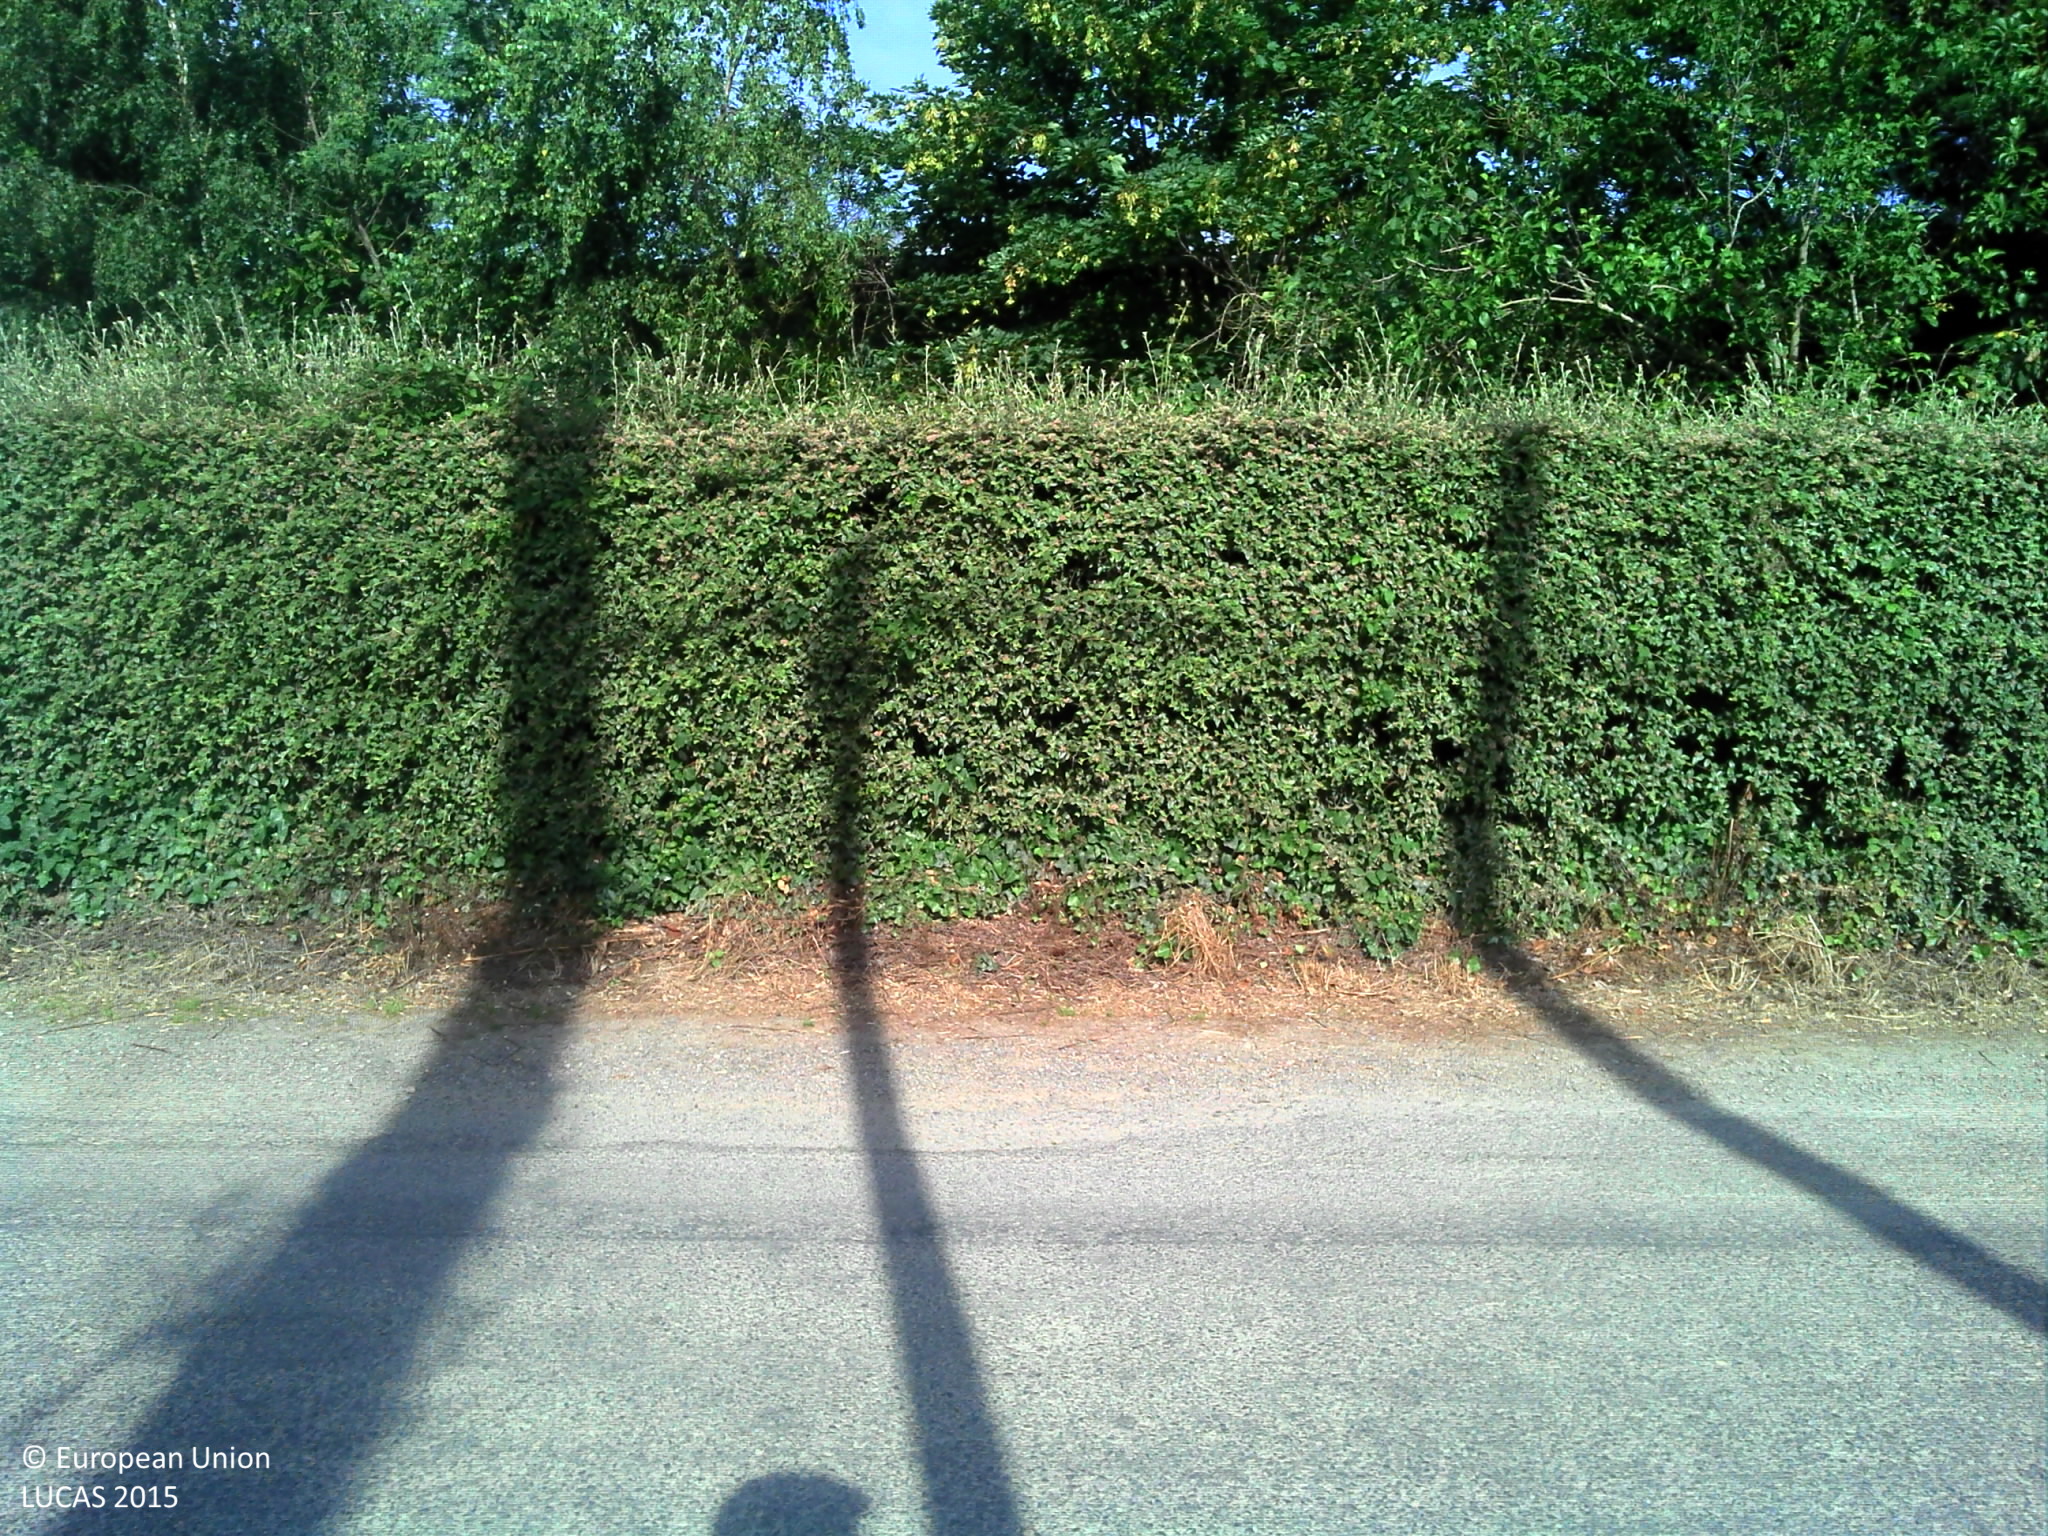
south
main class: Grassland
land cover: Grassland with sparse tree/shrub cover
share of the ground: > 75 %
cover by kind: herbaceous plants 95 %, broadleaved forest trees 5 %
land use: Residential
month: June
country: FR
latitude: 48.0268
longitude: -1.4290
